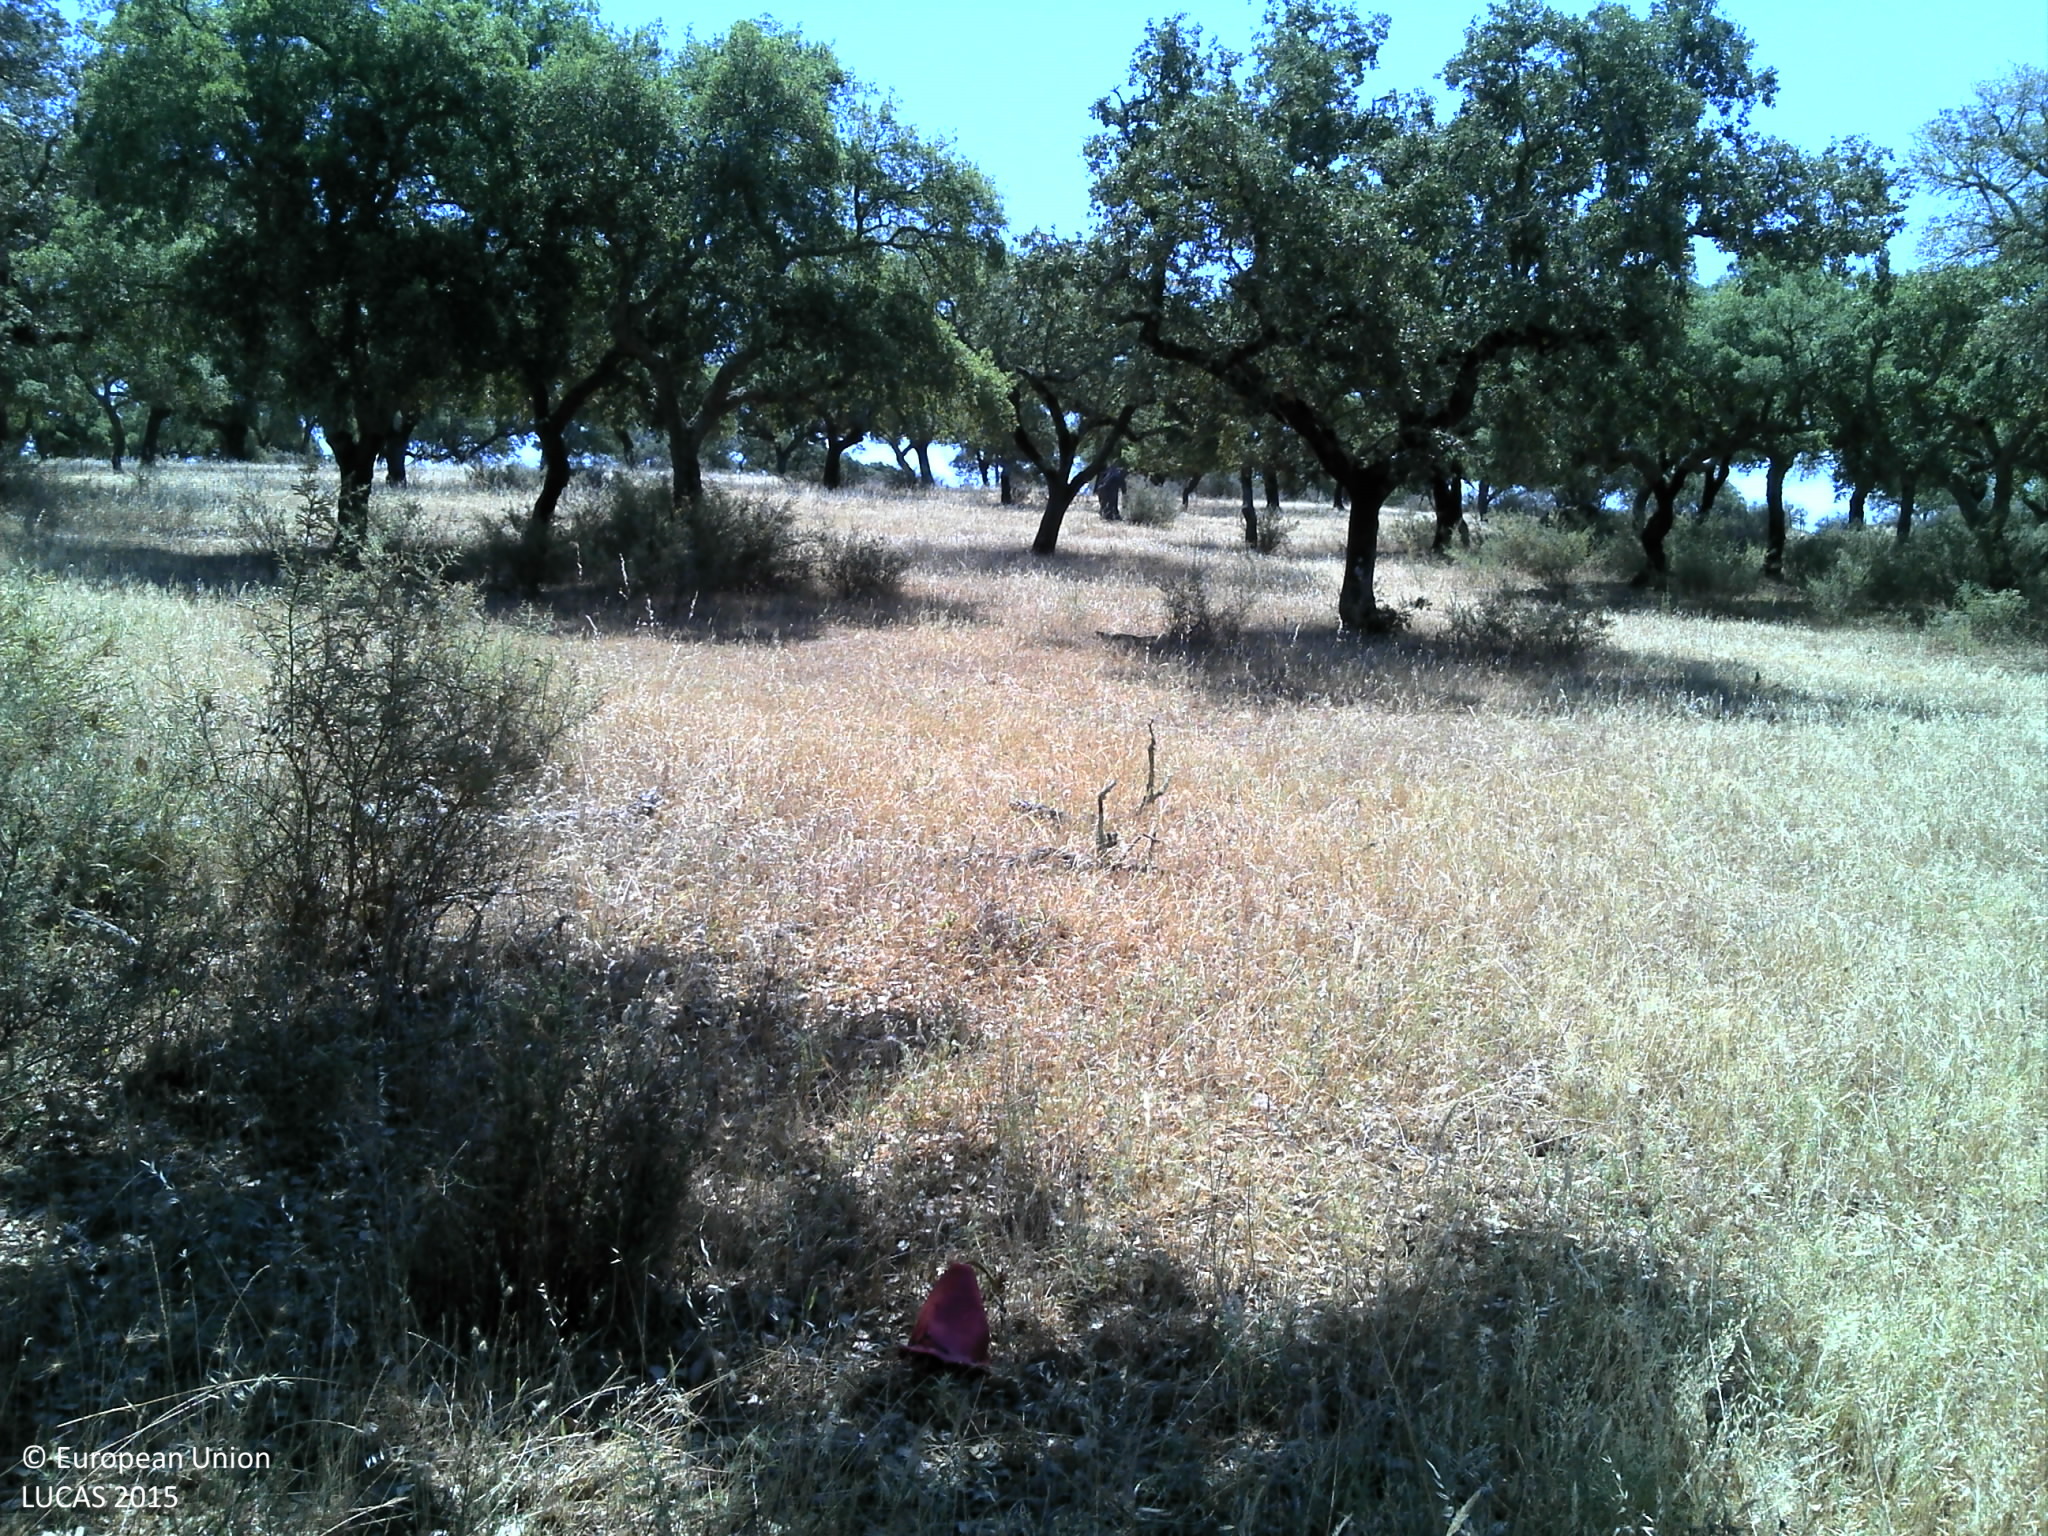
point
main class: Woodland
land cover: Broadleaved woodland
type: broadleaved evergreen forest
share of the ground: 50 - 75 %
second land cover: Grassland without tree/shrub cover
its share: 50 - 75 %
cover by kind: broadleaved forest trees 50 %, herbaceous plants 40 %, unconsolidated bare surface 10 %
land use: Forestry
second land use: Agriculture (excluding fallow land and kitchen gardens)
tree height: > 5 m
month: June
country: PT
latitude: 38.7683
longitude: -7.8229
